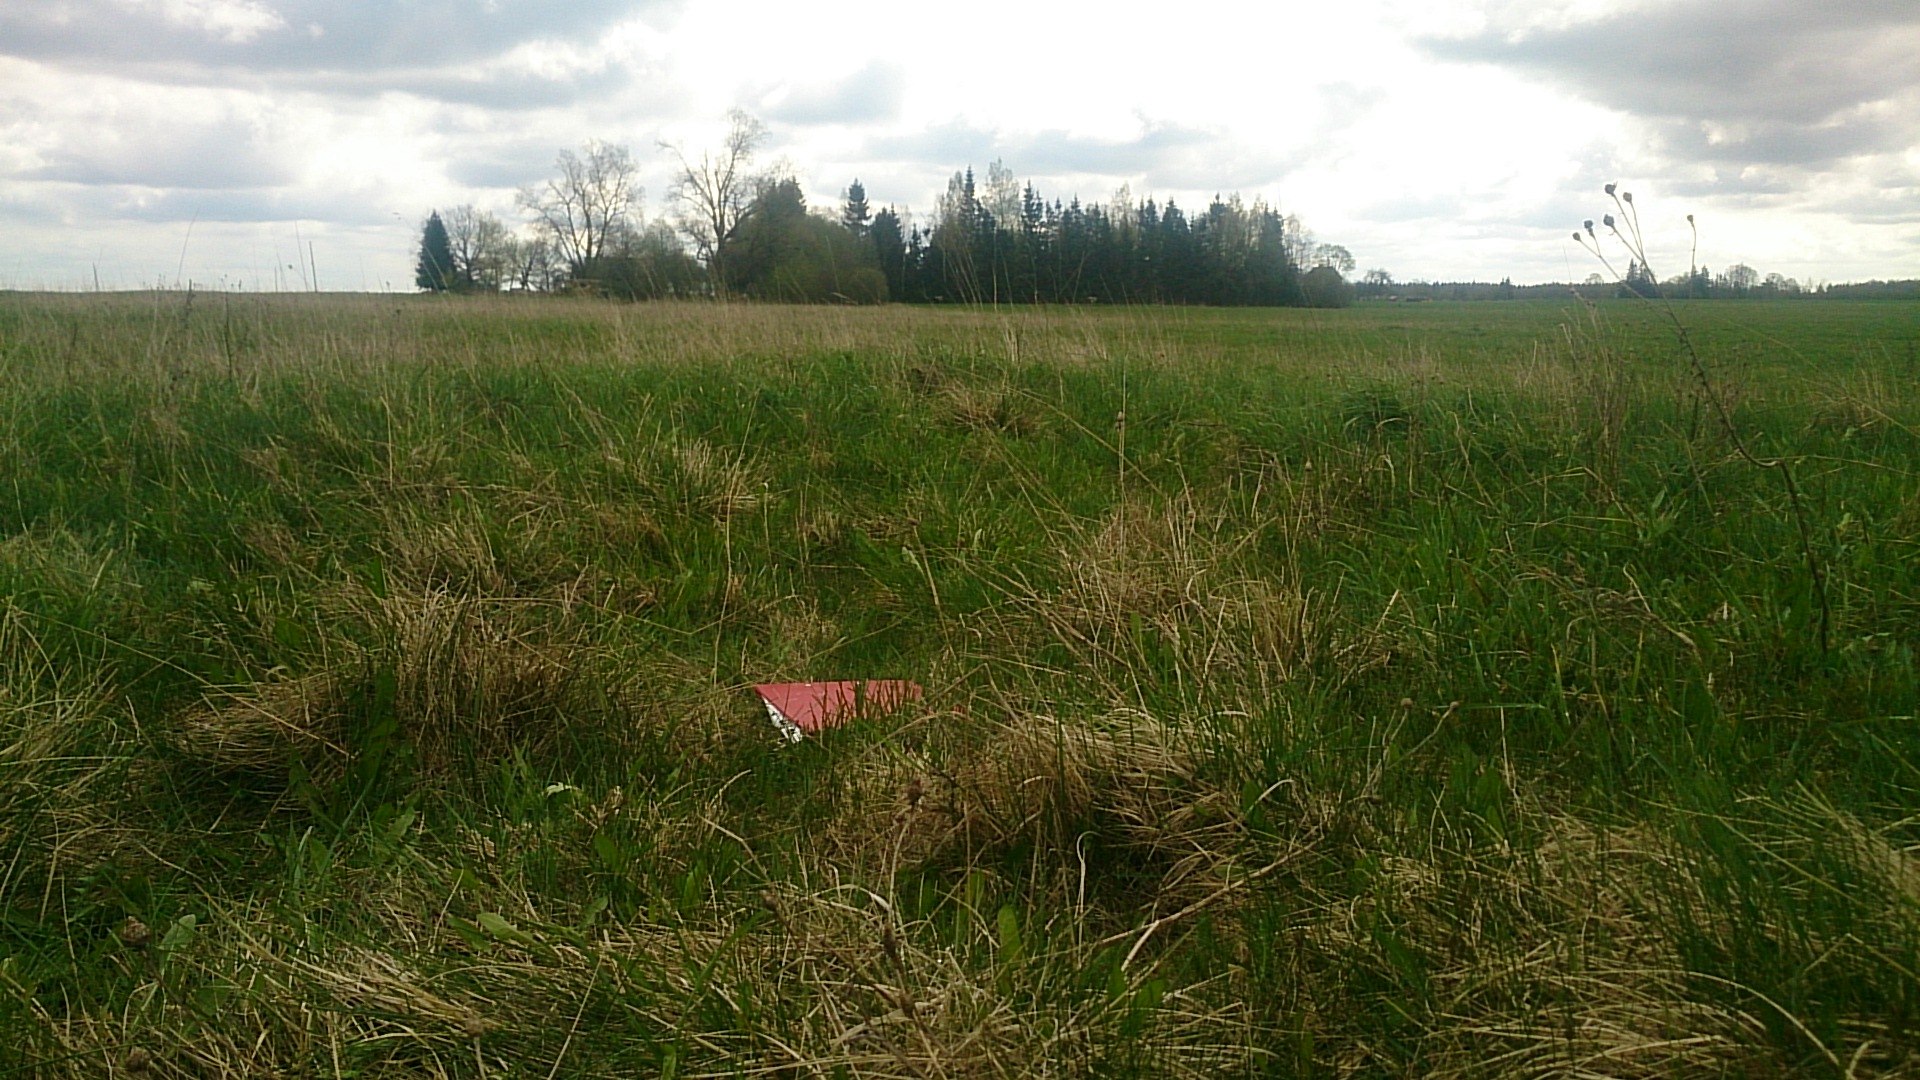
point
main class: Grassland
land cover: Grassland without tree/shrub cover
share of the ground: > 75 %
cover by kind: herbaceous plants 100 %
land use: Agriculture (excluding fallow land and kitchen gardens)
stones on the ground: < 10 %
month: May
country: LT
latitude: 56.3672
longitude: 22.0136
